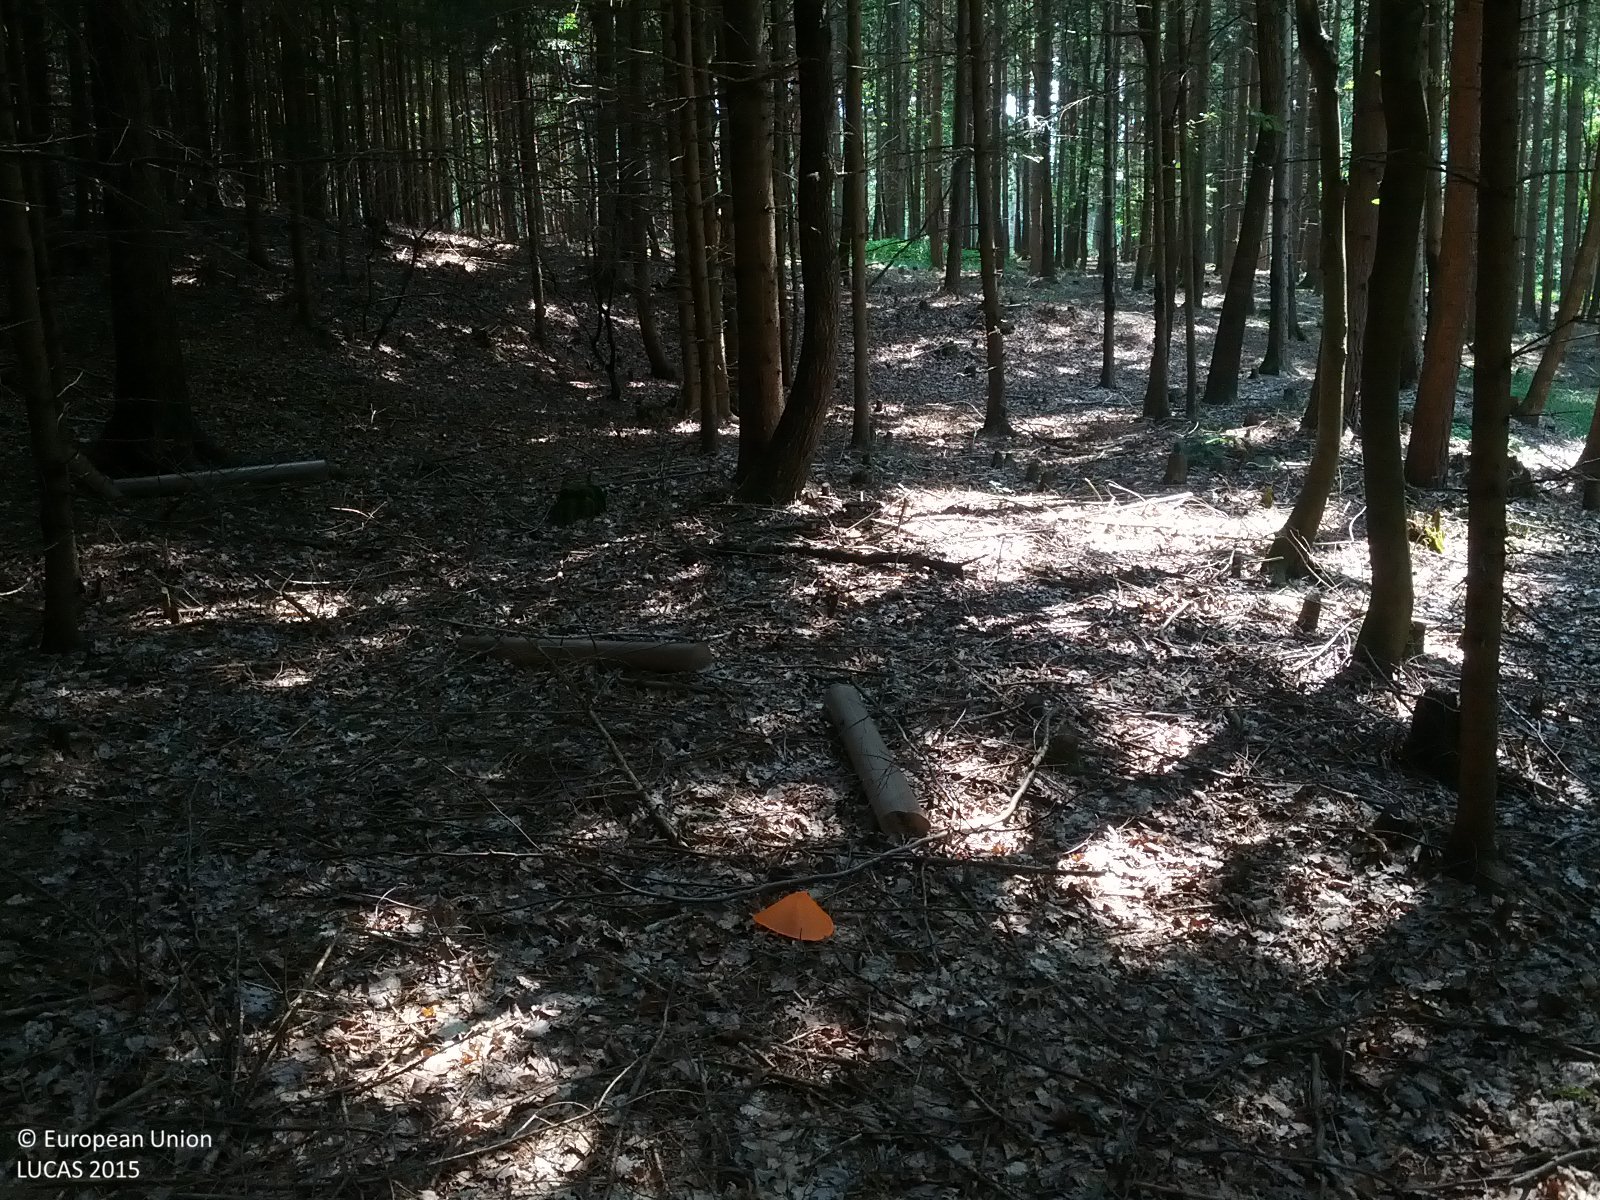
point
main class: Woodland
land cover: Spruce dominated coniferous woodland
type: hemiboreal forest and nemoral coniferous forest and mixed broadleaved-coniferous forest
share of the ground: > 75 %
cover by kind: coniferous forest trees 90 %, herbaceous plants 5 %, unconsolidated bare surface 5 %
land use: Forestry
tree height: > 5 m
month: July
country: AT
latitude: 47.2593
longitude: 16.1206
